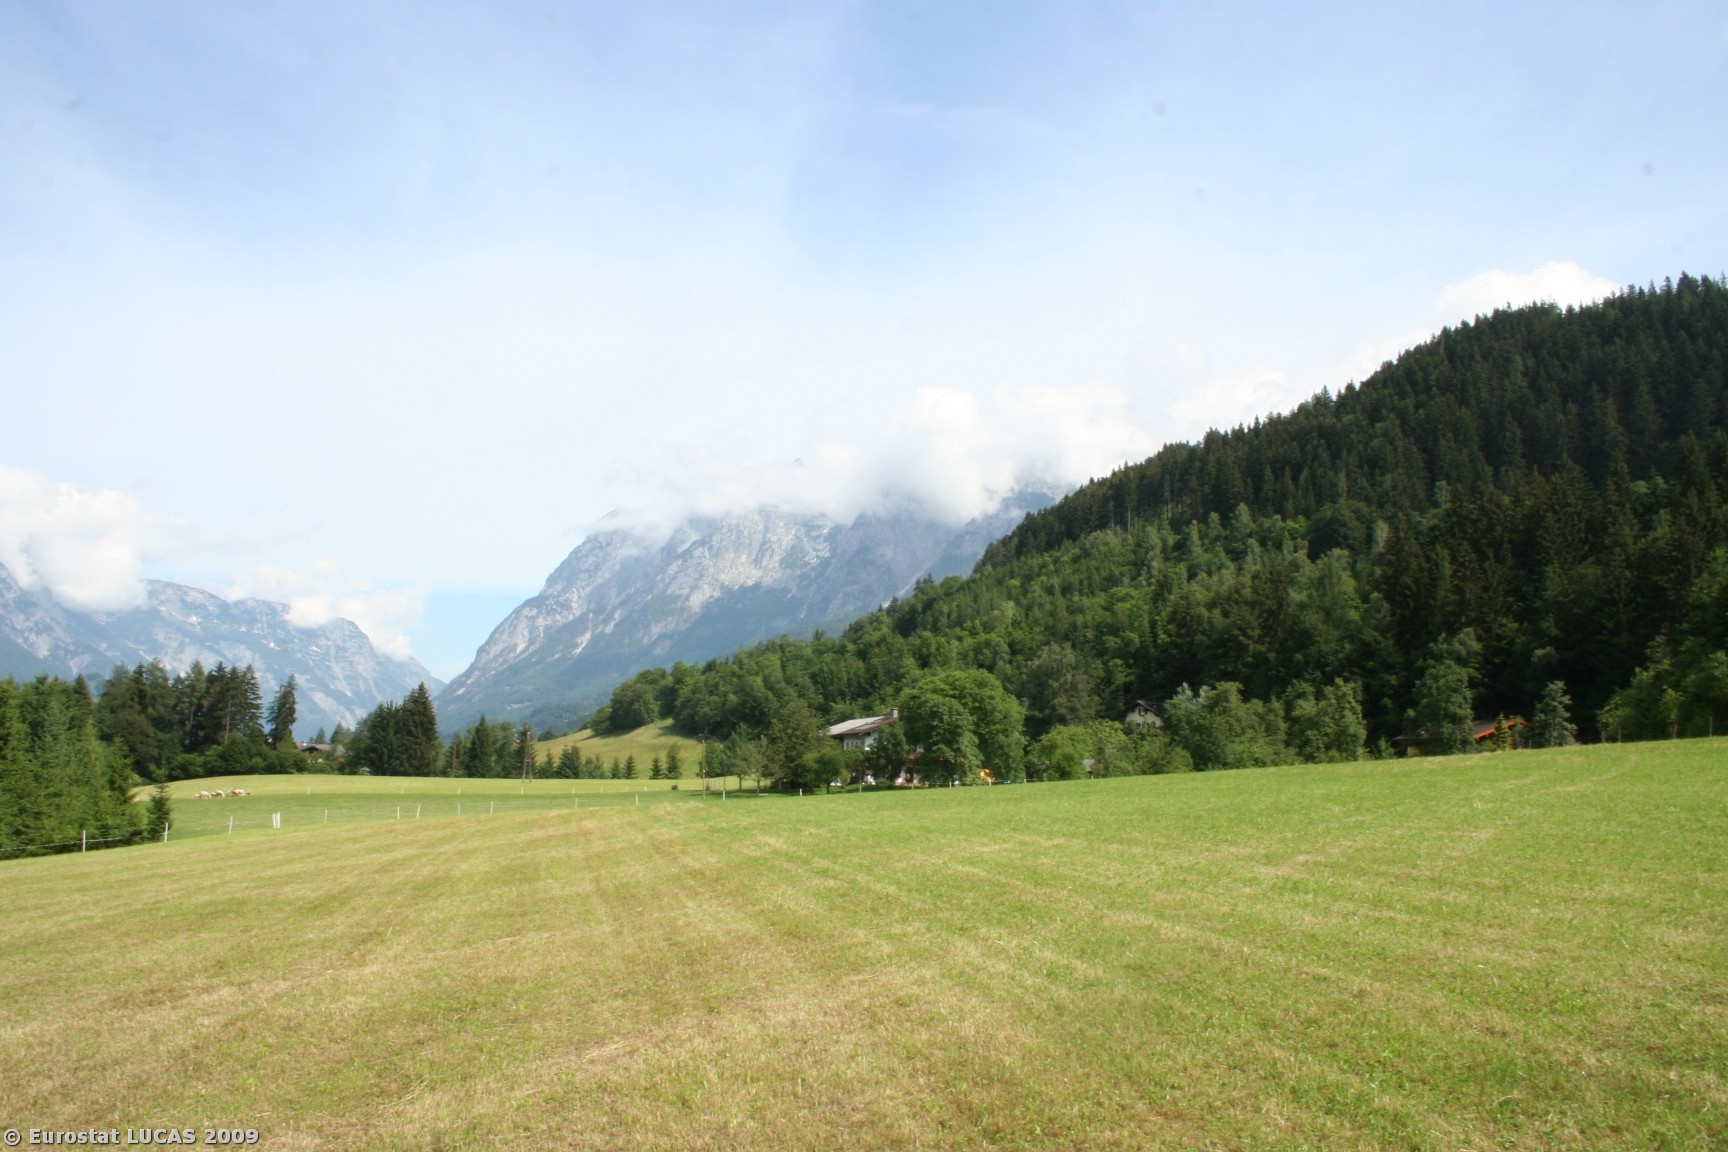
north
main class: Grassland
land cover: Grassland without tree/shrub cover
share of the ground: > 75 %
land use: Agriculture (excluding fallow land and kitchen gardens)
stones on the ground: < 10 %
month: June
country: AT
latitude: 47.4380
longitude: 13.2203
